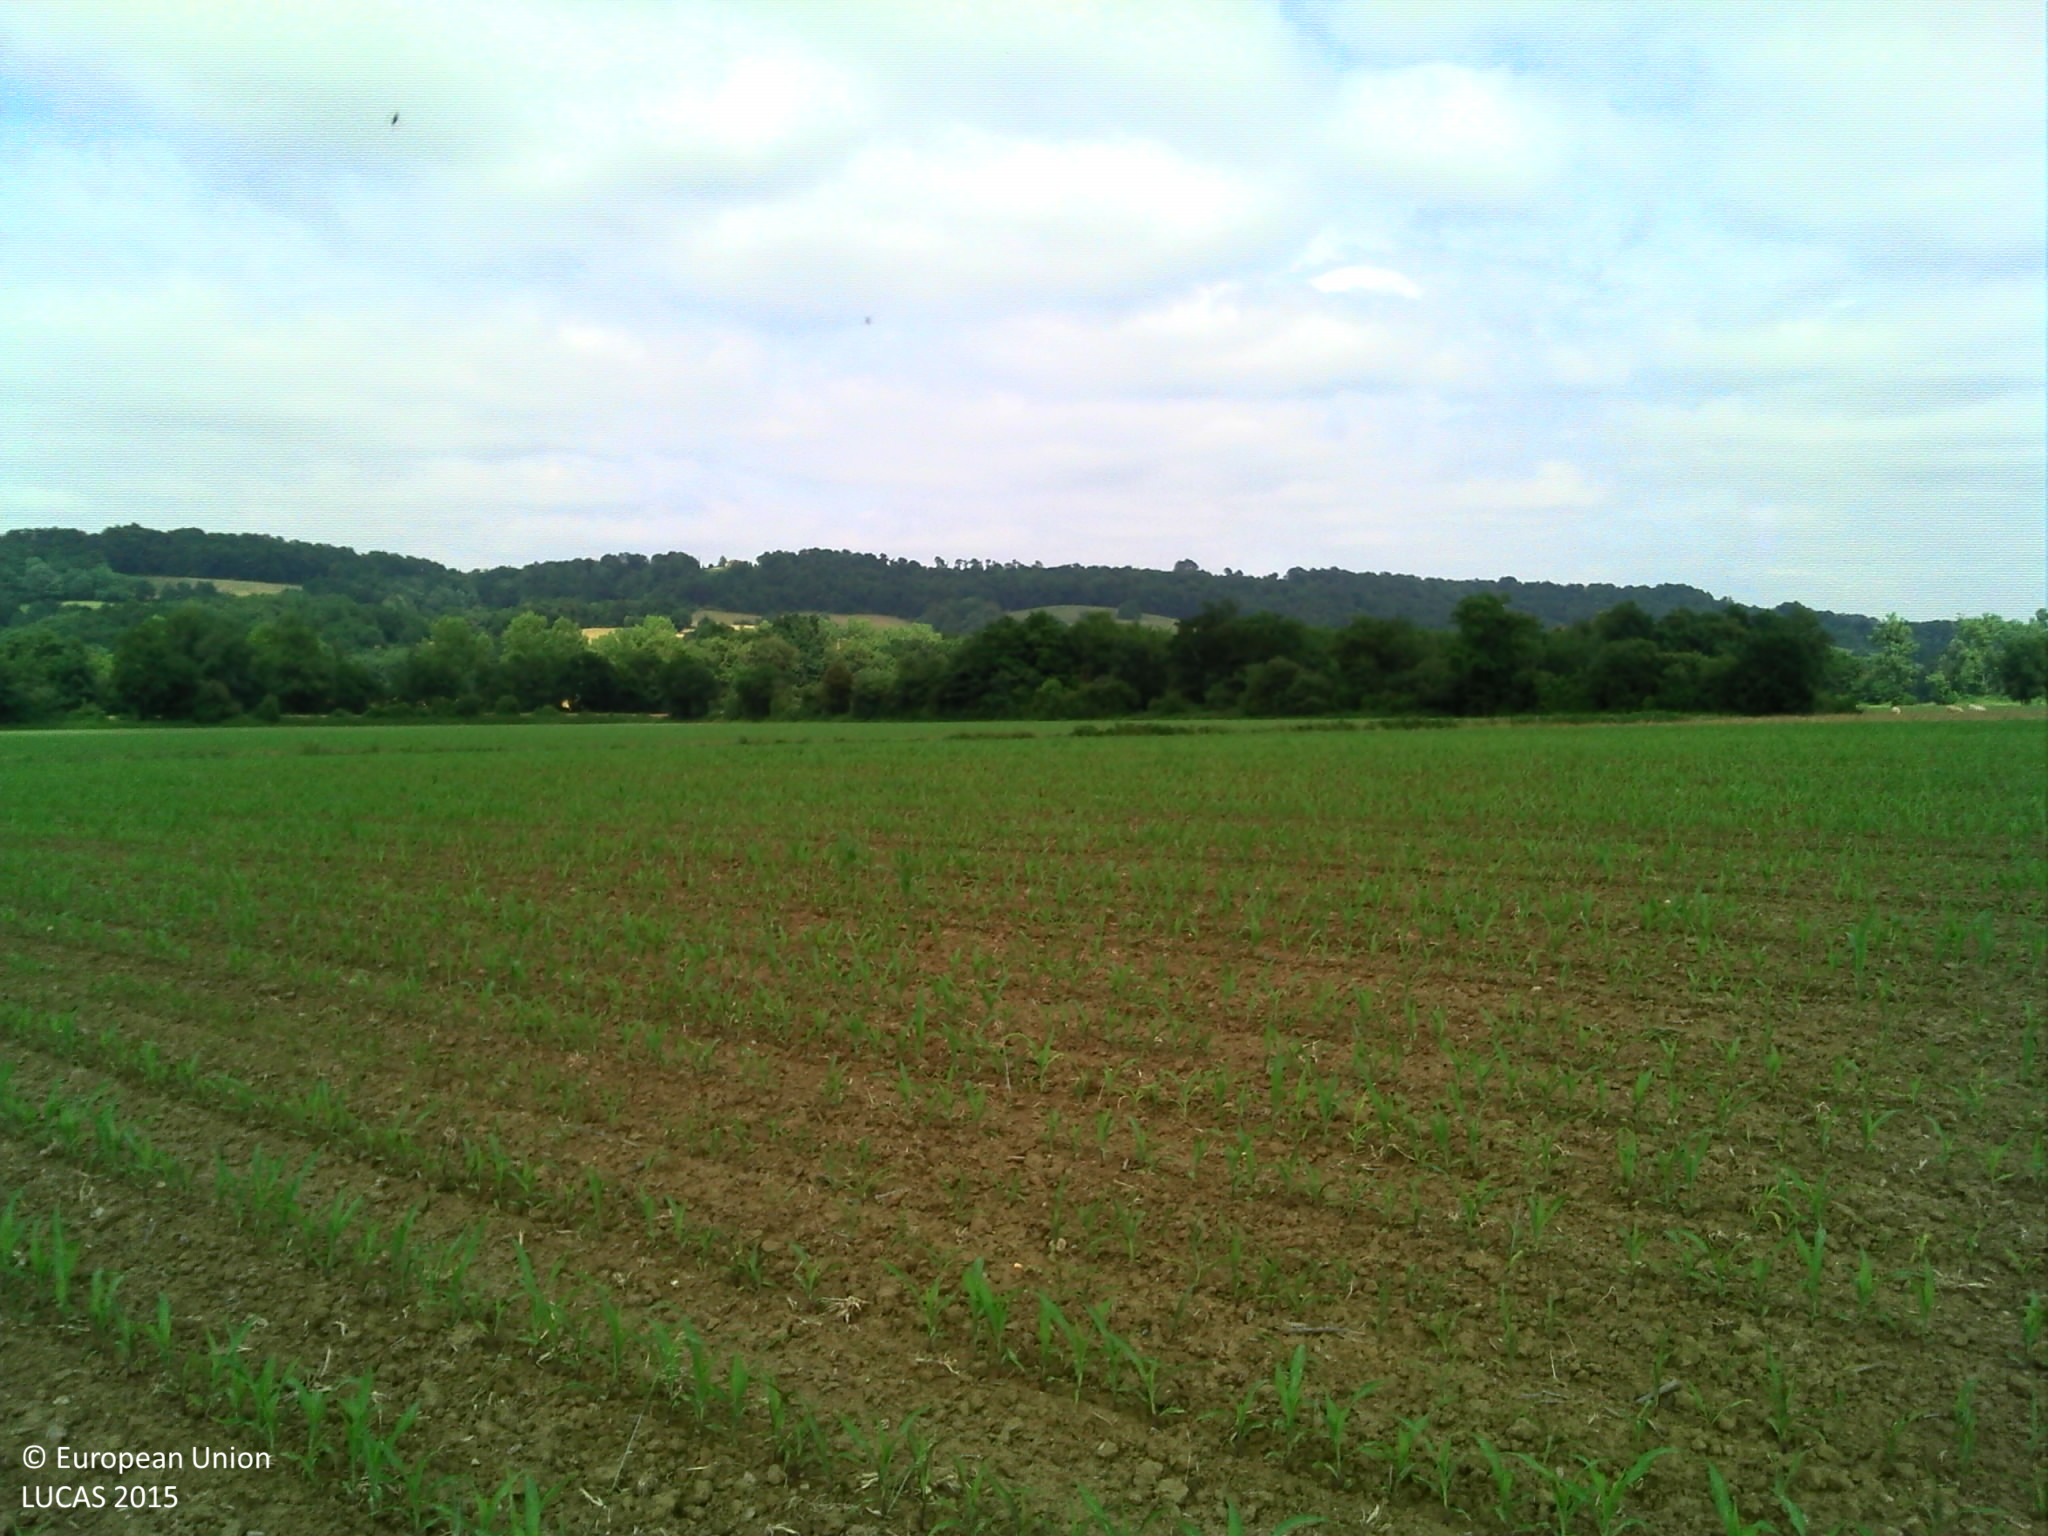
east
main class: Cropland
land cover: Maize
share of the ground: 10 - 25 %
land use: Agriculture (excluding fallow land and kitchen gardens)
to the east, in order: Maize; Grass margins; Shruby margins; Maize
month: June
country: FR
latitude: 43.6100
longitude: -0.2046
